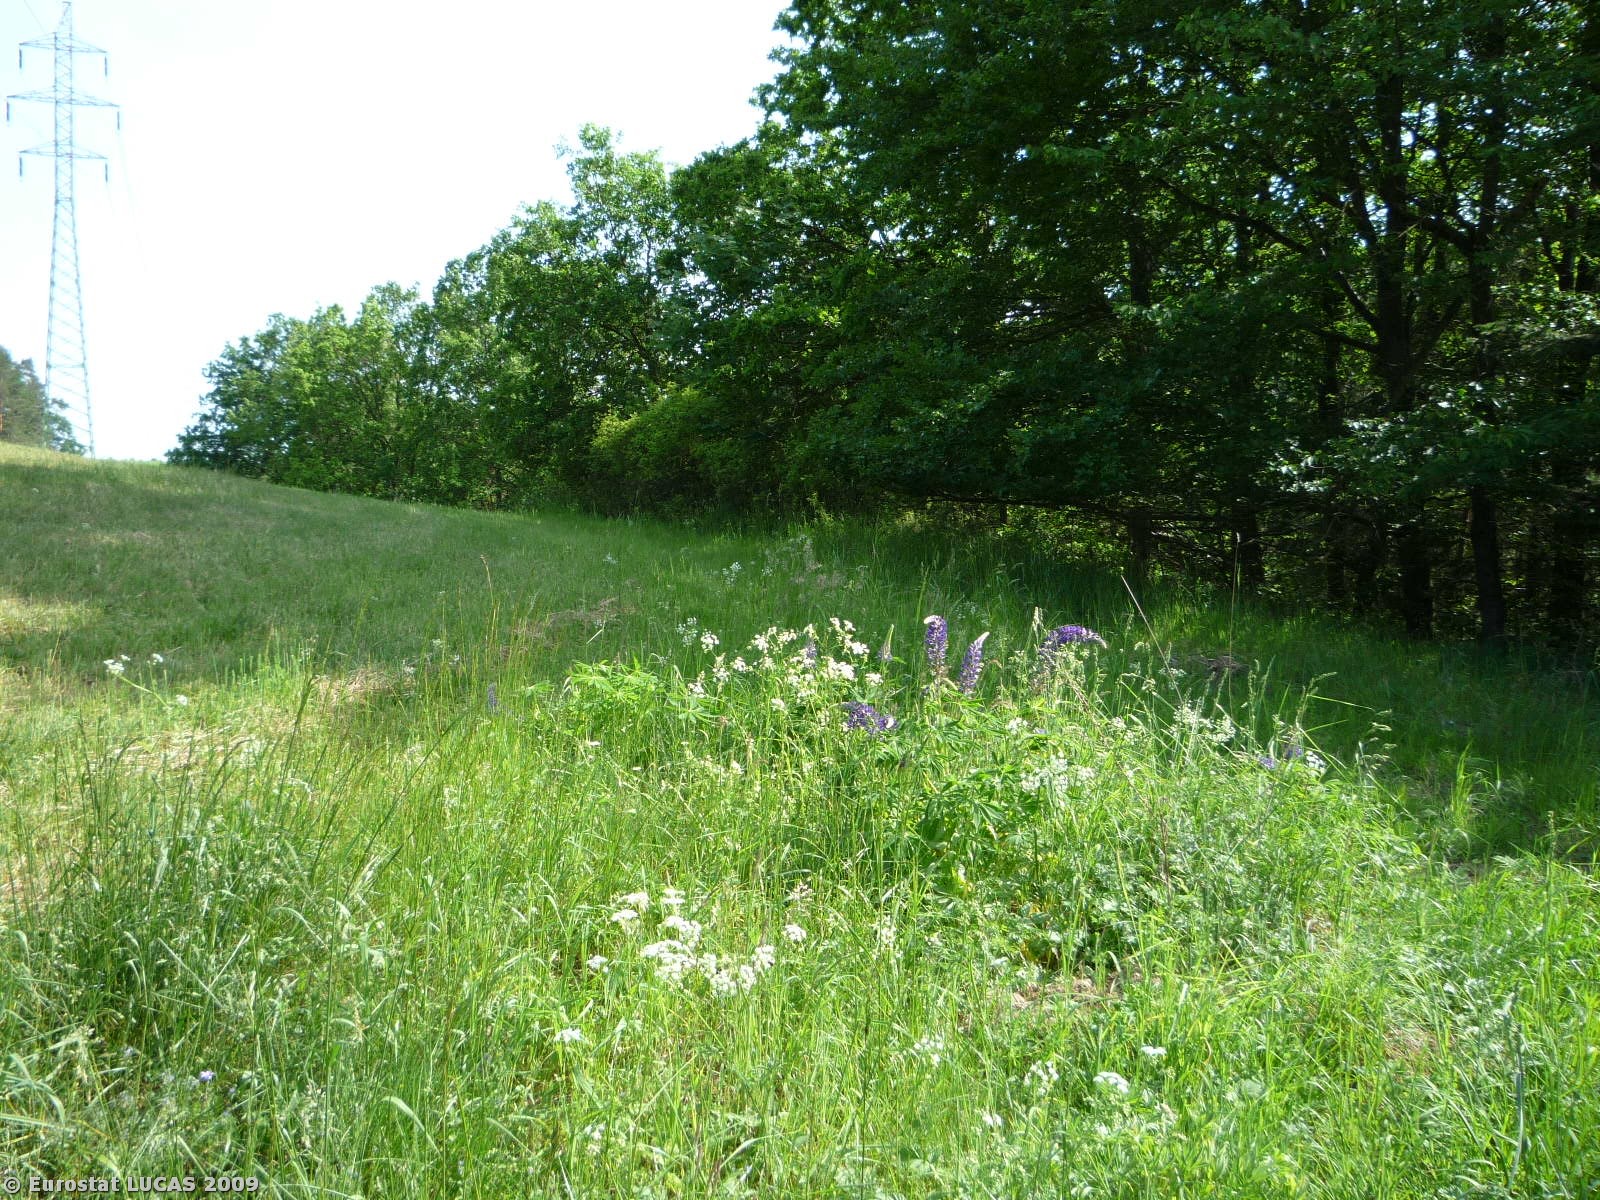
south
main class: Grassland
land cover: Spontaneously vegetated surfaces
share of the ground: > 75 %
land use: Fallow land
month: May
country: CZ
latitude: 49.7318
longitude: 15.0111
